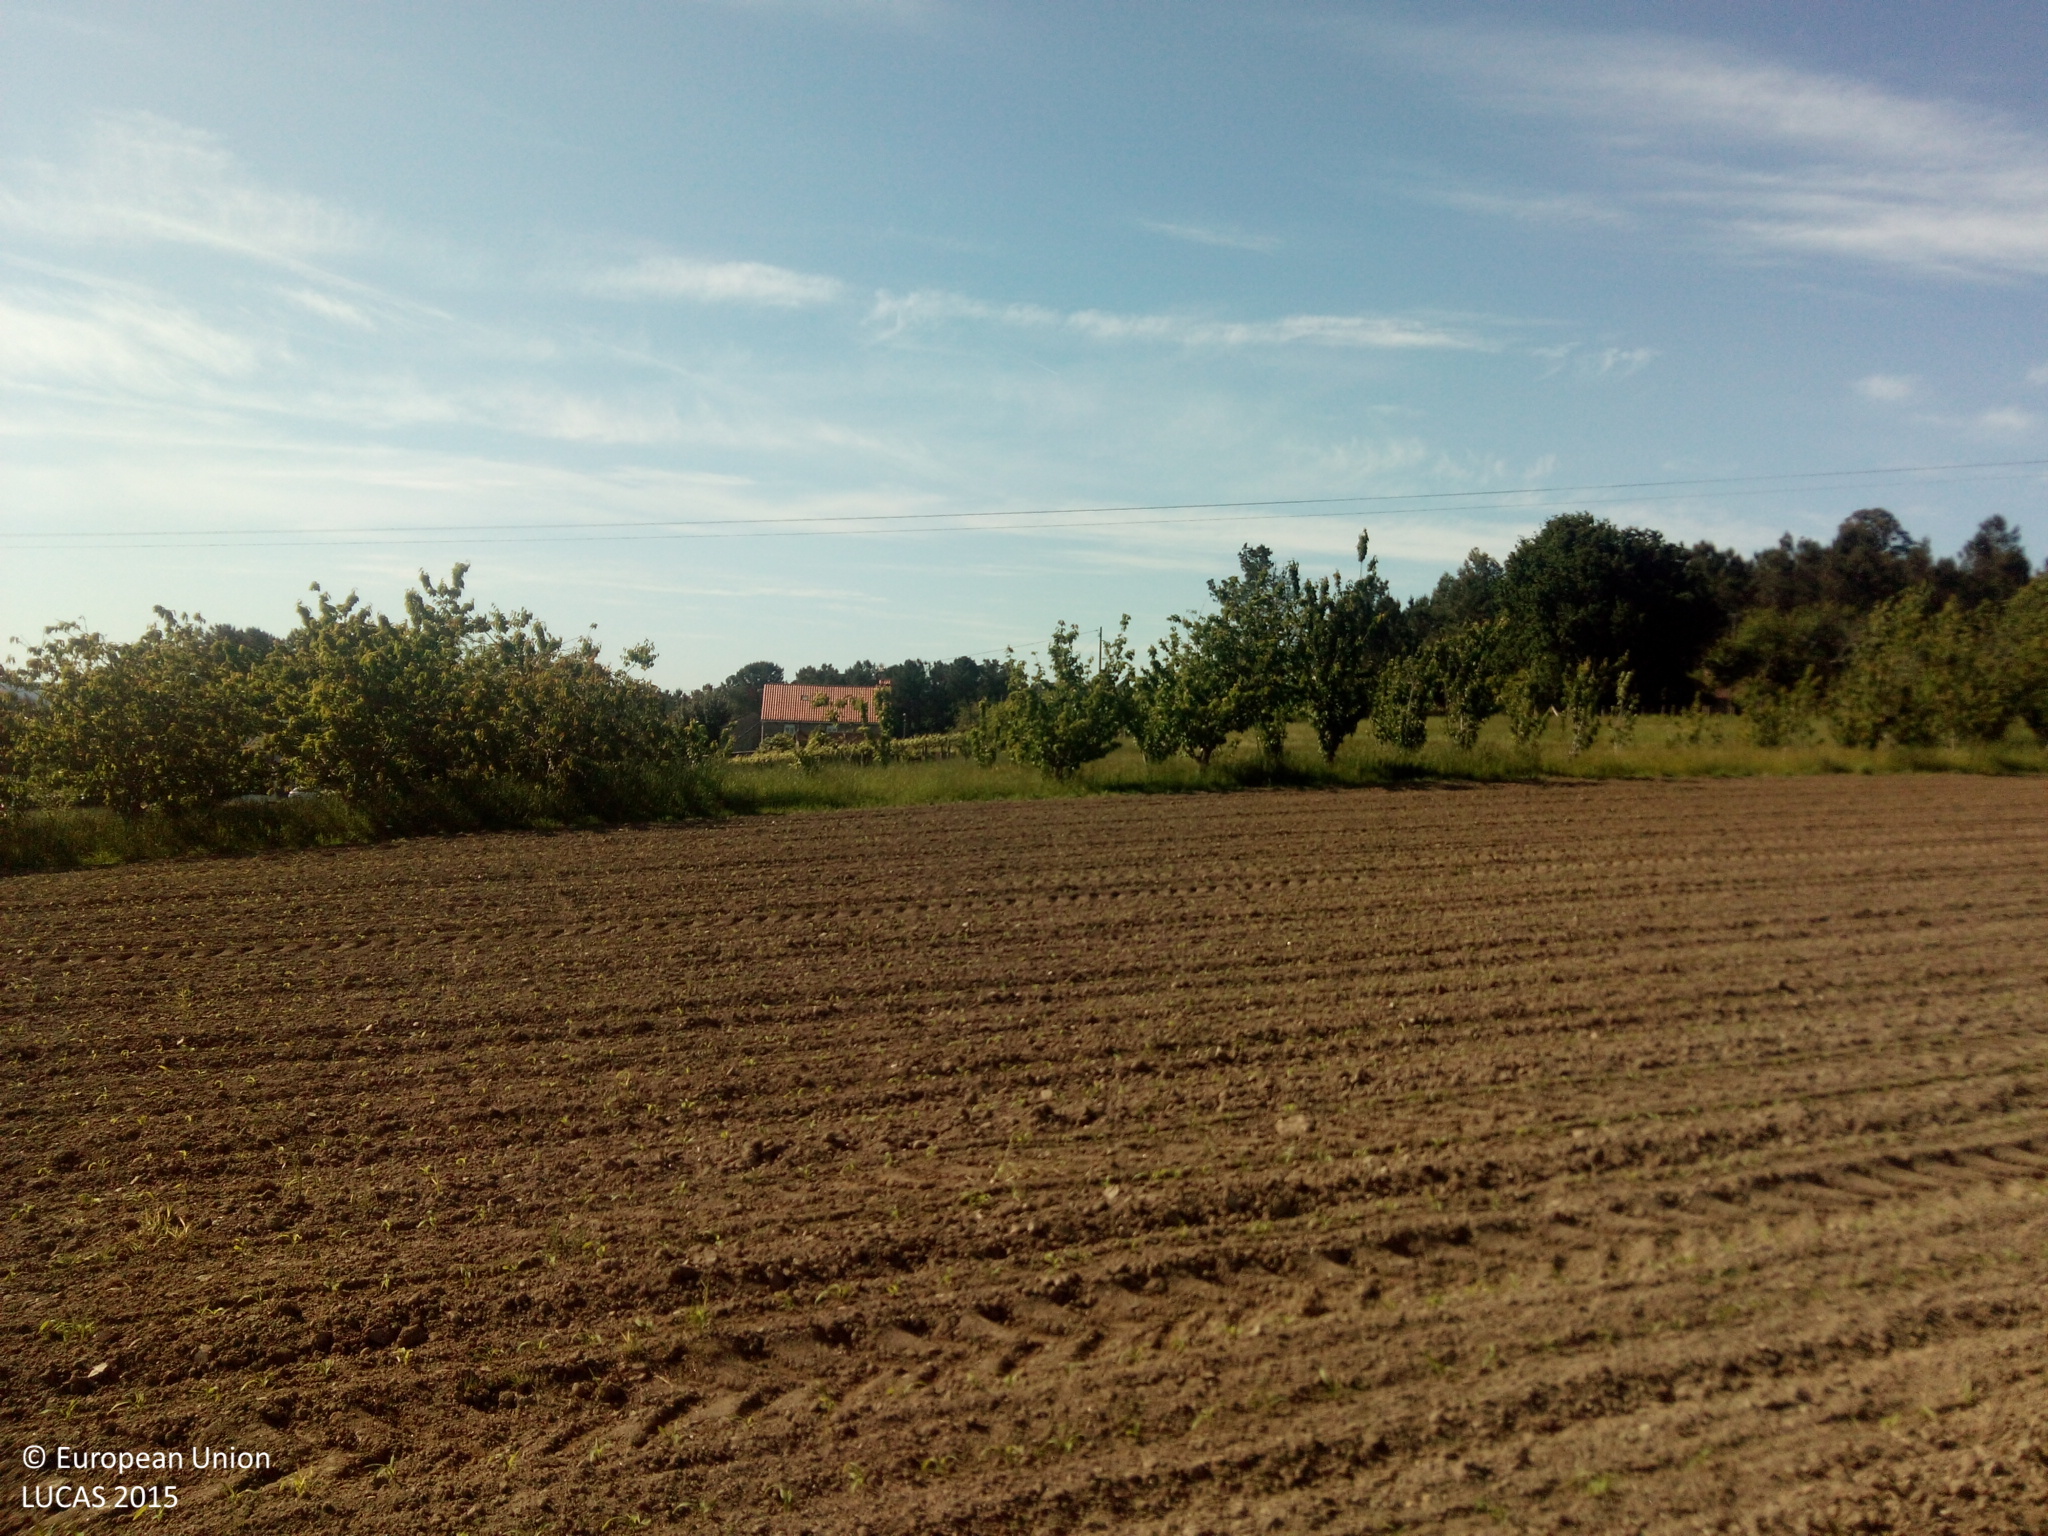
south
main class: Cropland
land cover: Maize
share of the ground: > 75 %
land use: Agriculture (excluding fallow land and kitchen gardens)
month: May
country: ES
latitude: 42.7149
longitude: -8.4519
